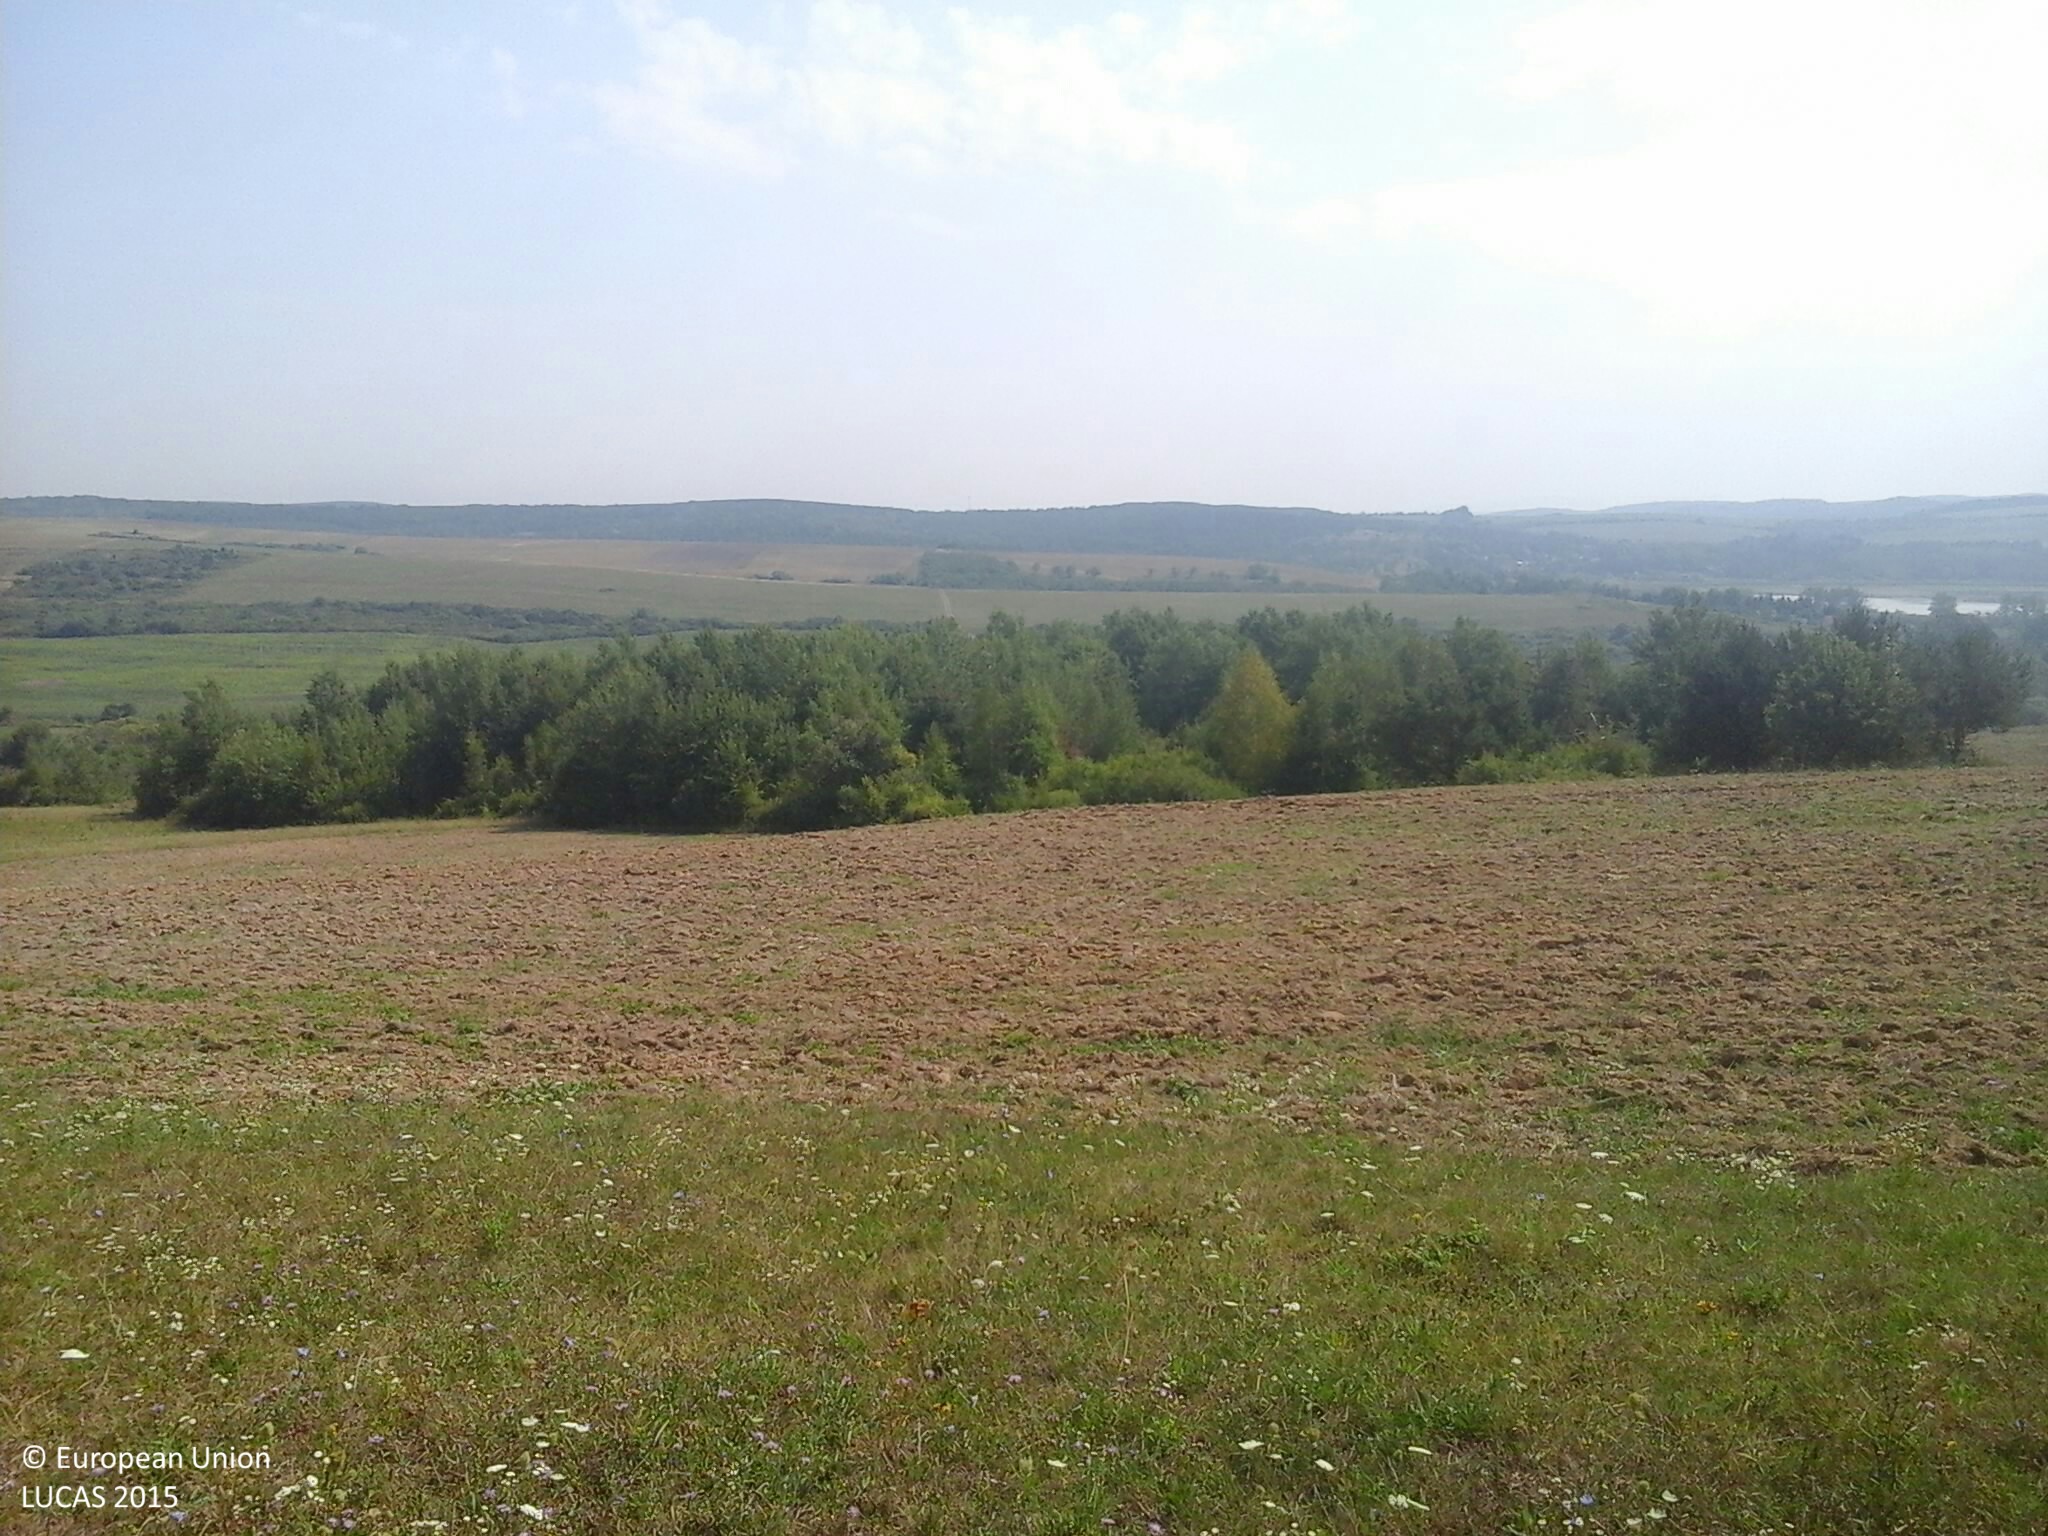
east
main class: Grassland
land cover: Grassland without tree/shrub cover
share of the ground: > 75 %
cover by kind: herbaceous plants 100 %
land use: Agriculture (excluding fallow land and kitchen gardens)
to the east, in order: Grassland without tree/shrub cover; Shrubland with sparse tree cover
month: August
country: HU
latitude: 48.4575
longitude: 20.7609
